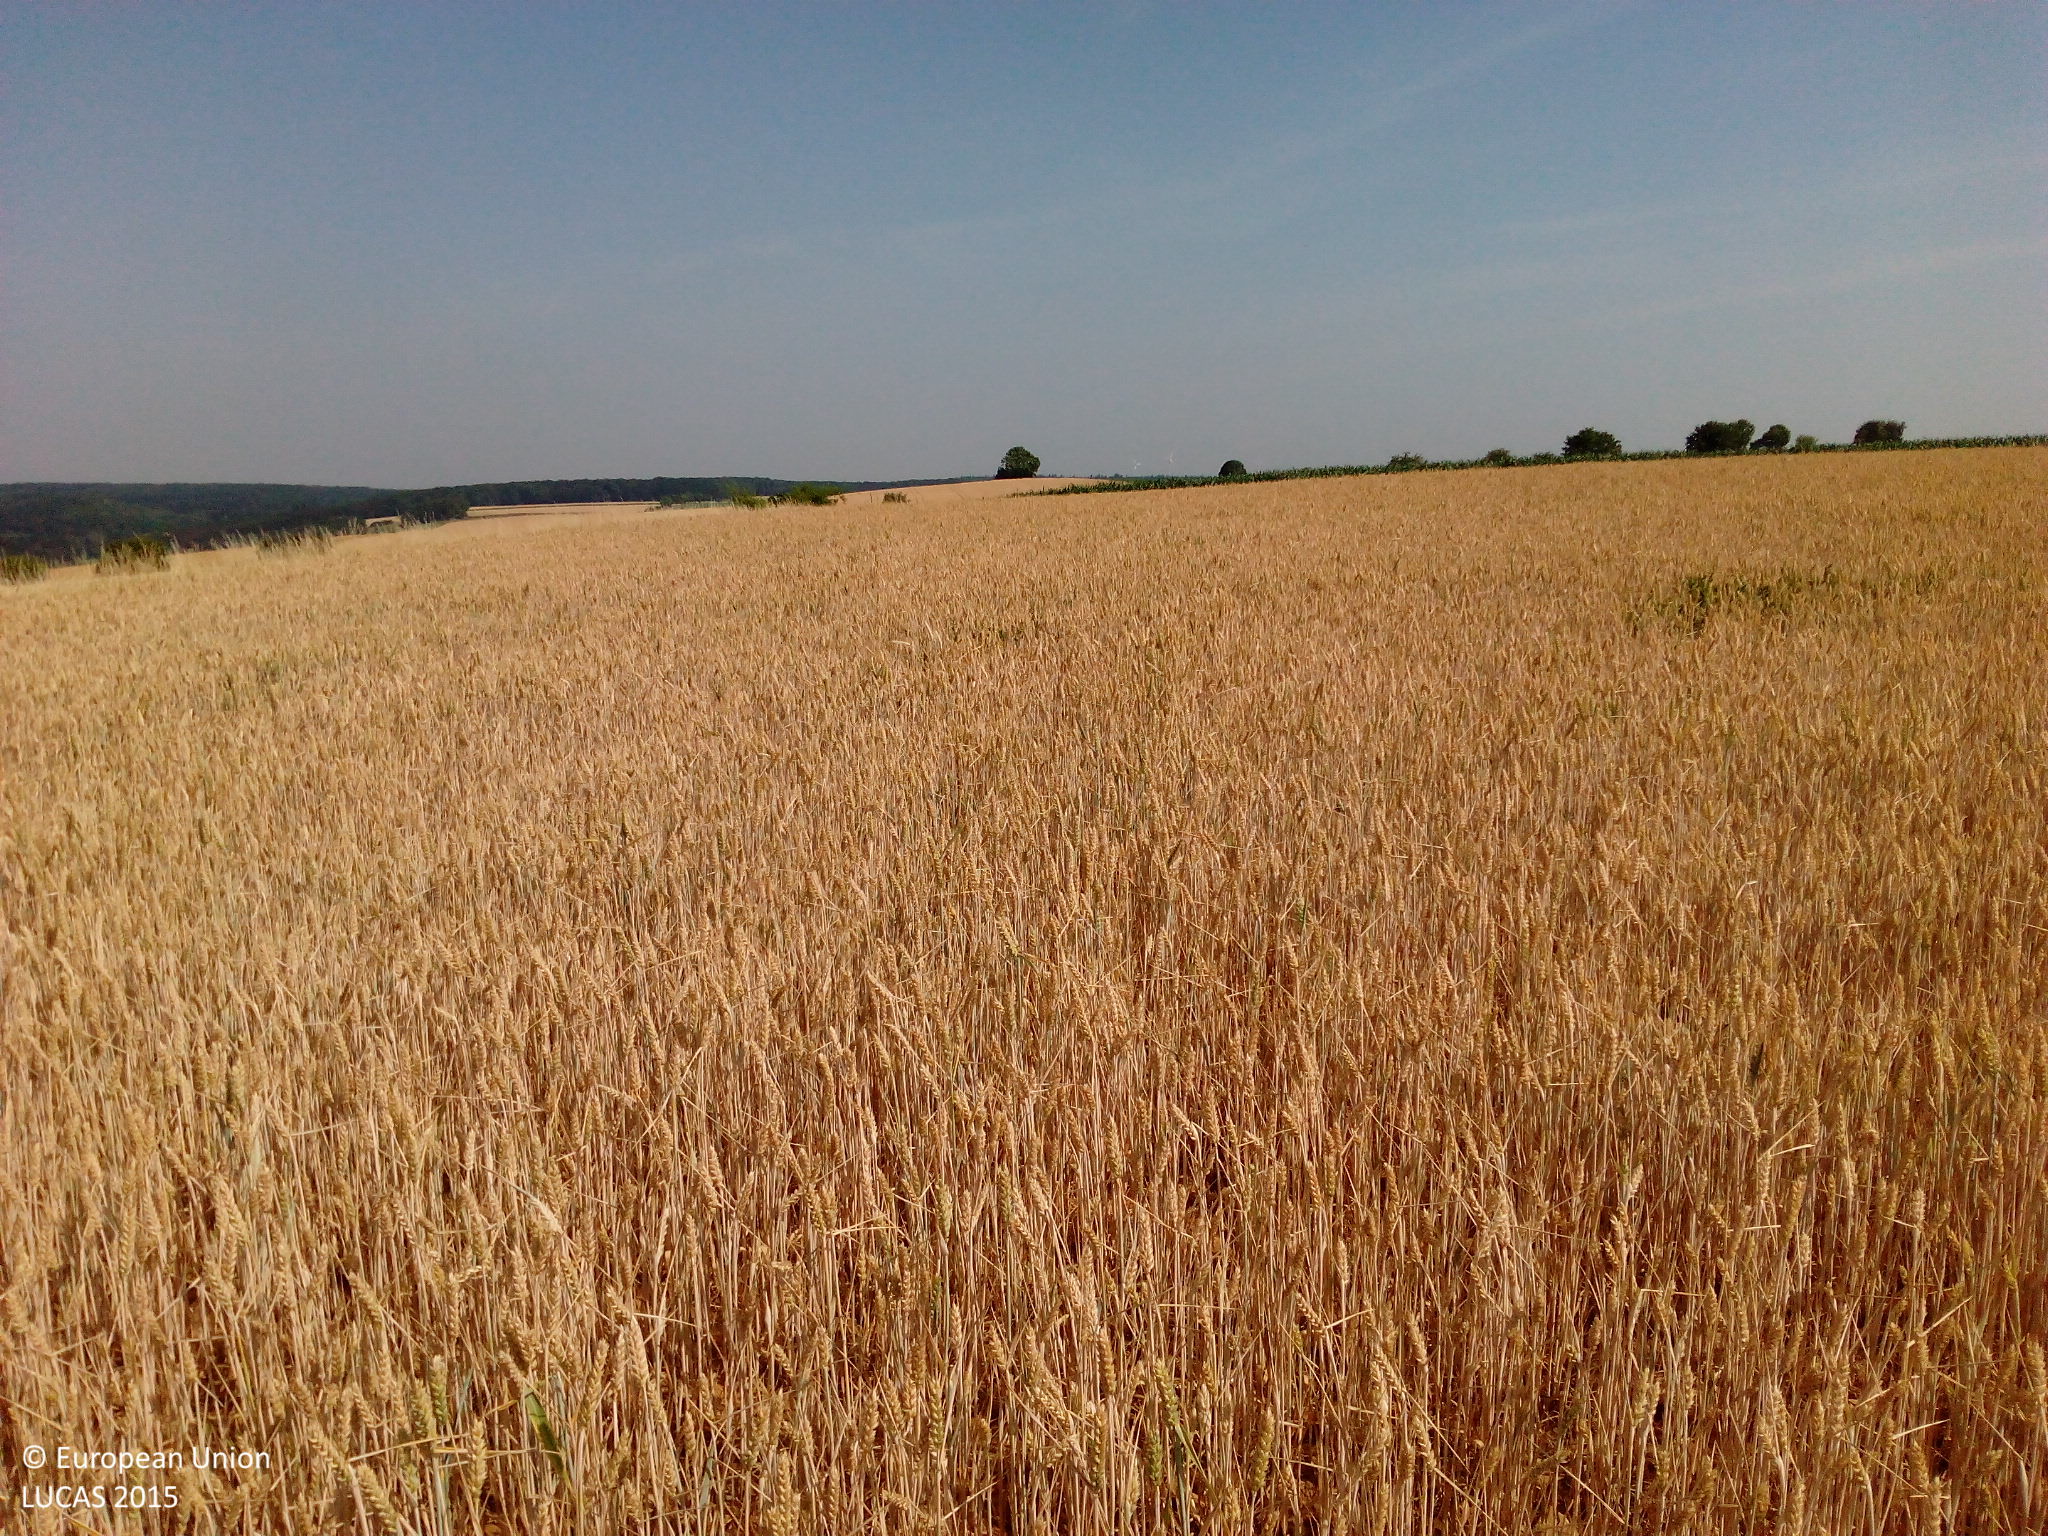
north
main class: Cropland
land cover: Common wheat
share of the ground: > 75 %
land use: Agriculture (excluding fallow land and kitchen gardens)
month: July
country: DE
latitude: 49.5188
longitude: 9.9033
